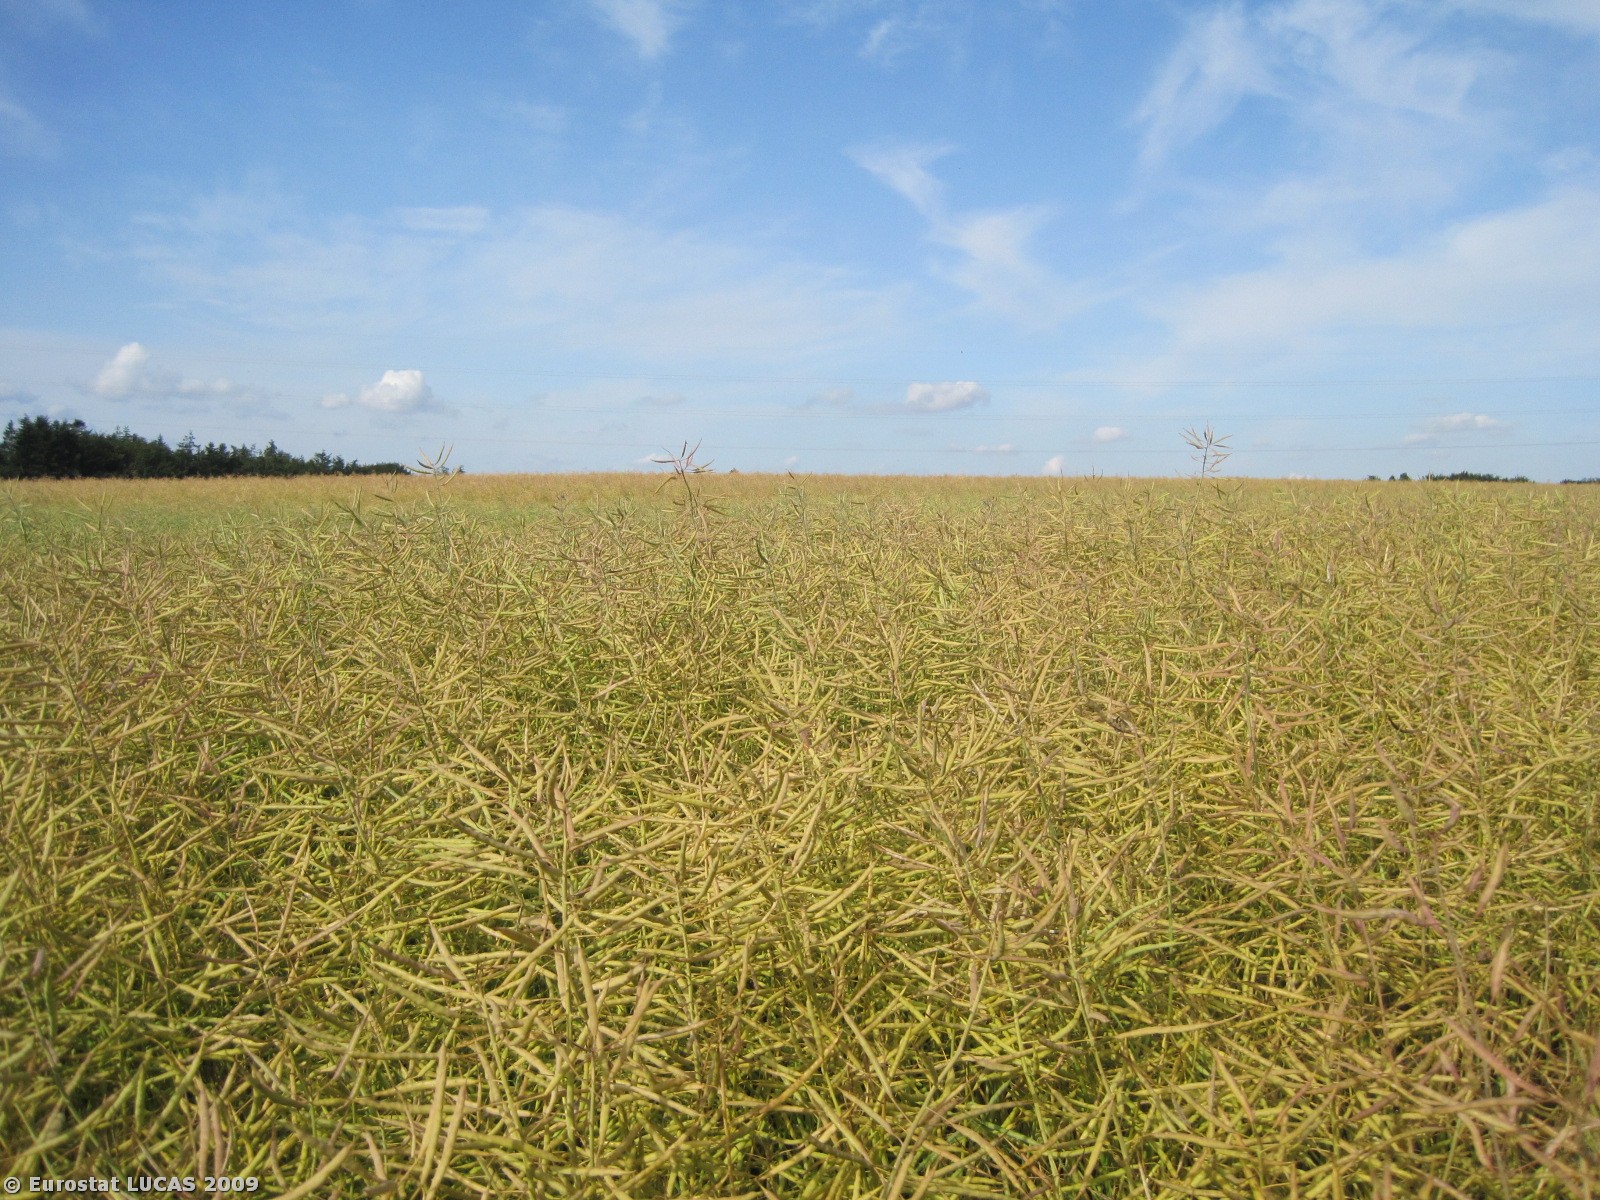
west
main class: Cropland
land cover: Rape and turnip rape
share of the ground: > 75 %
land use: Agriculture (excluding fallow land and kitchen gardens)
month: July
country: DK
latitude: 56.6190
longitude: 9.7884
